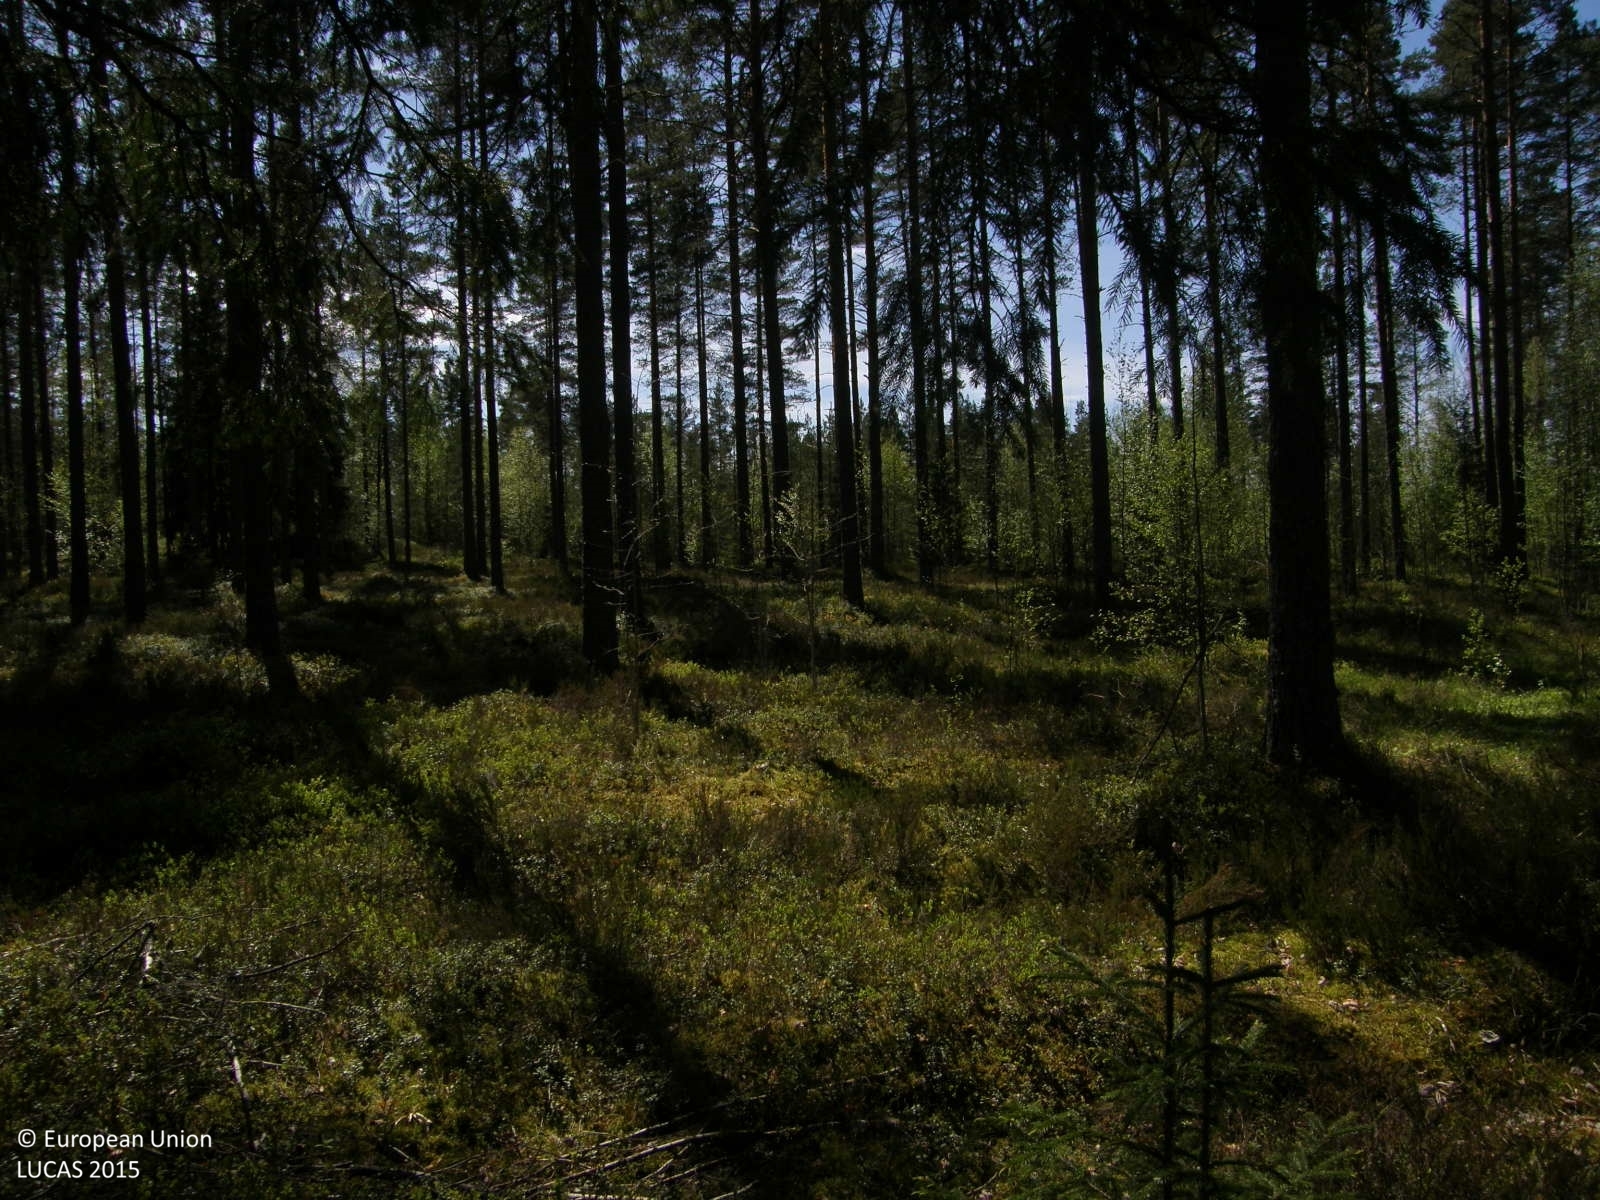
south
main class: Woodland
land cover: Pine dominated coniferous woodland
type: boreal forest
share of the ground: 50 - 75 %
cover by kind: coniferous forest trees 70 %, shrubs 30 %
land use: Forestry
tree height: > 5 m
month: June
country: FI
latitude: 62.1444
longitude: 22.2761
